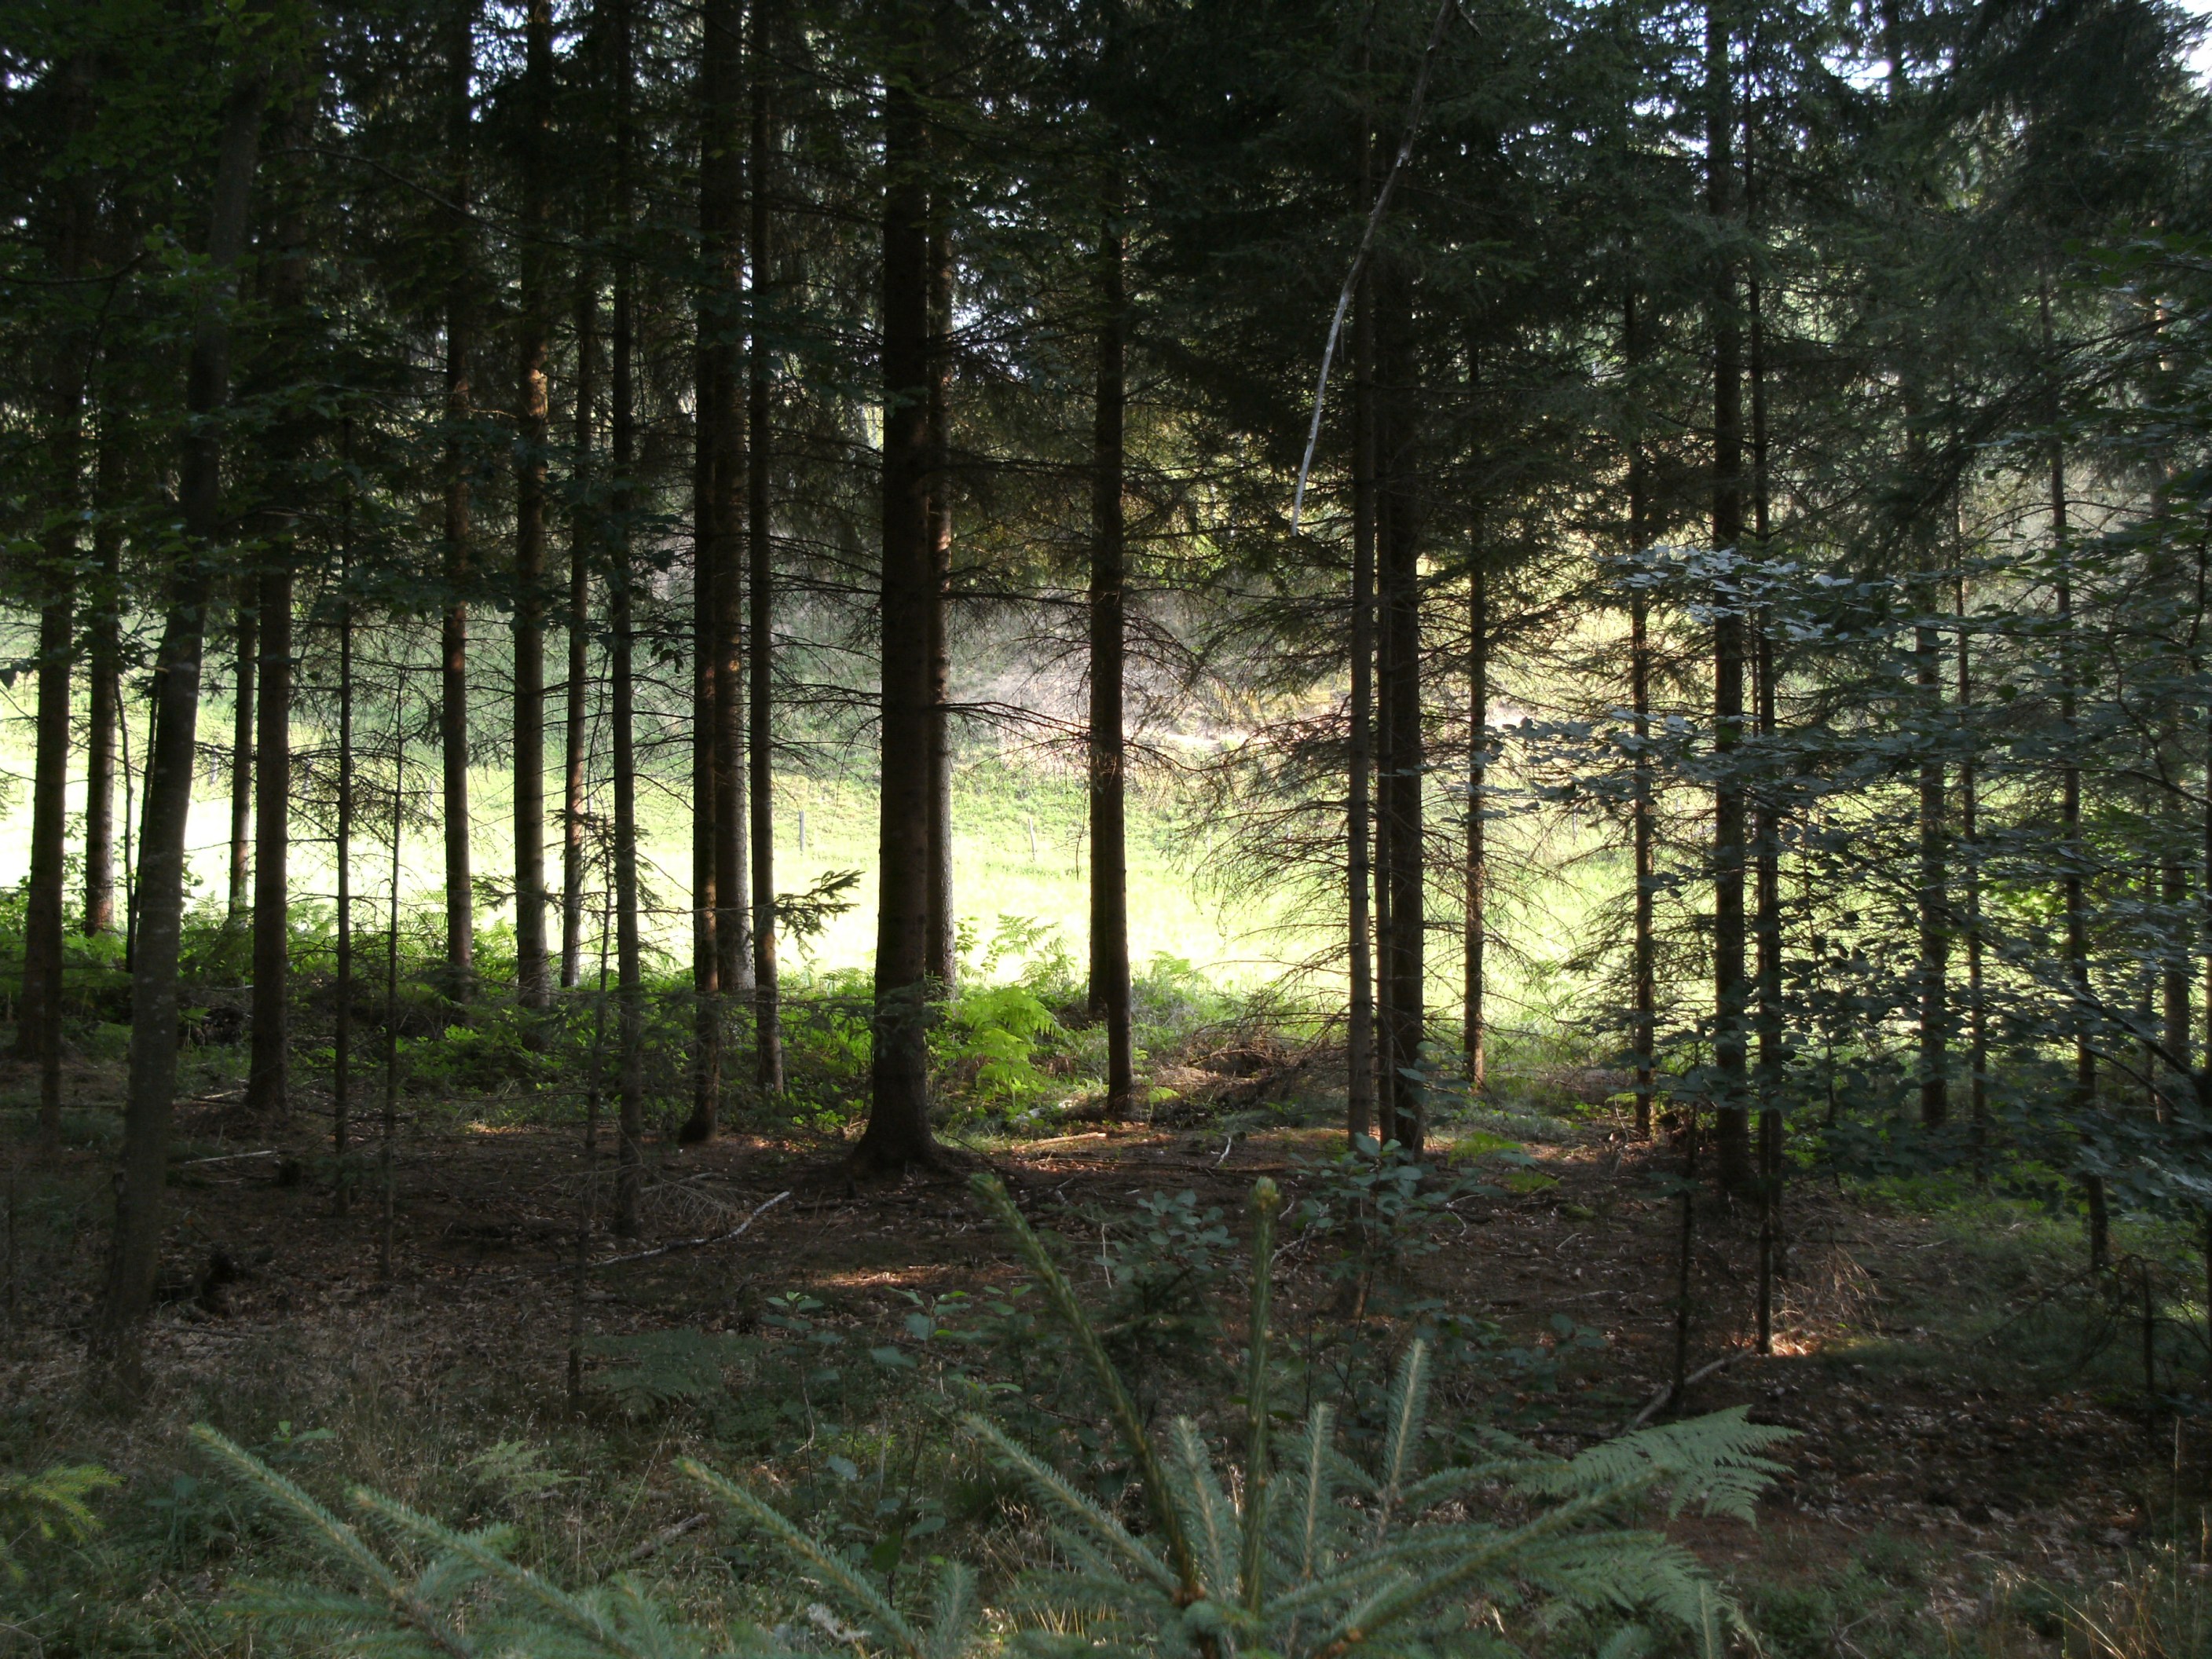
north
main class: Woodland
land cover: Spruce dominated coniferous woodland
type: hemiboreal forest and nemoral coniferous forest and mixed broadleaved-coniferous forest
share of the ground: 25 - 50 %
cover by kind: coniferous forest trees 45 %, shrubs 15 %, herbaceous plants 15 %, unconsolidated bare surface 15 %, broadleaved forest trees 5 %, lichens and mosses 5 %
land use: Forestry
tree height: > 5 m
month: July
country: AT
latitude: 46.7426
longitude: 14.9327
